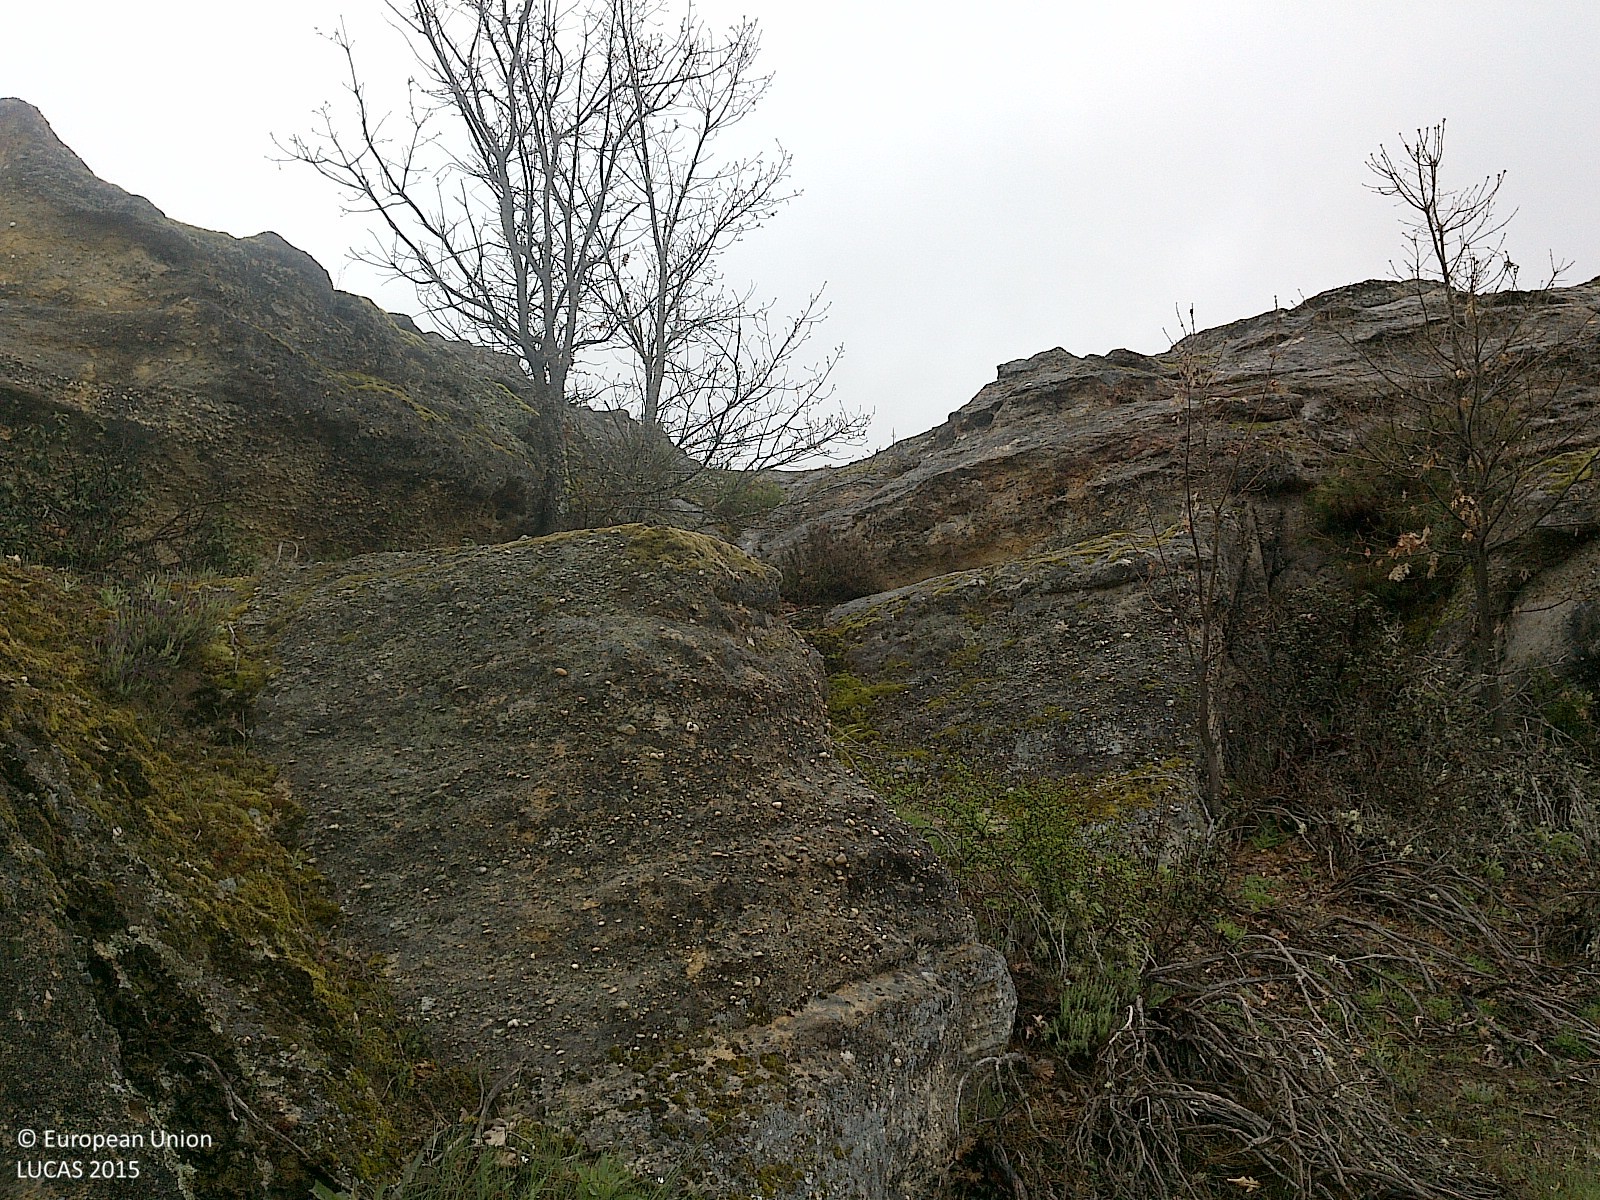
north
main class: Shrubland
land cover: Shrubland with sparse tree cover
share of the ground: 25 - 50 %
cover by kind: consolidated bare surface 55 %, shrubs 25 %, lichens and mosses 10 %, broadleaved forest trees 5 %, herbaceous plants 5 %
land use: Semi-natural and natural areas not in use
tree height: > 5 m
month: May
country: ES
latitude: 41.9136
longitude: -3.2023
